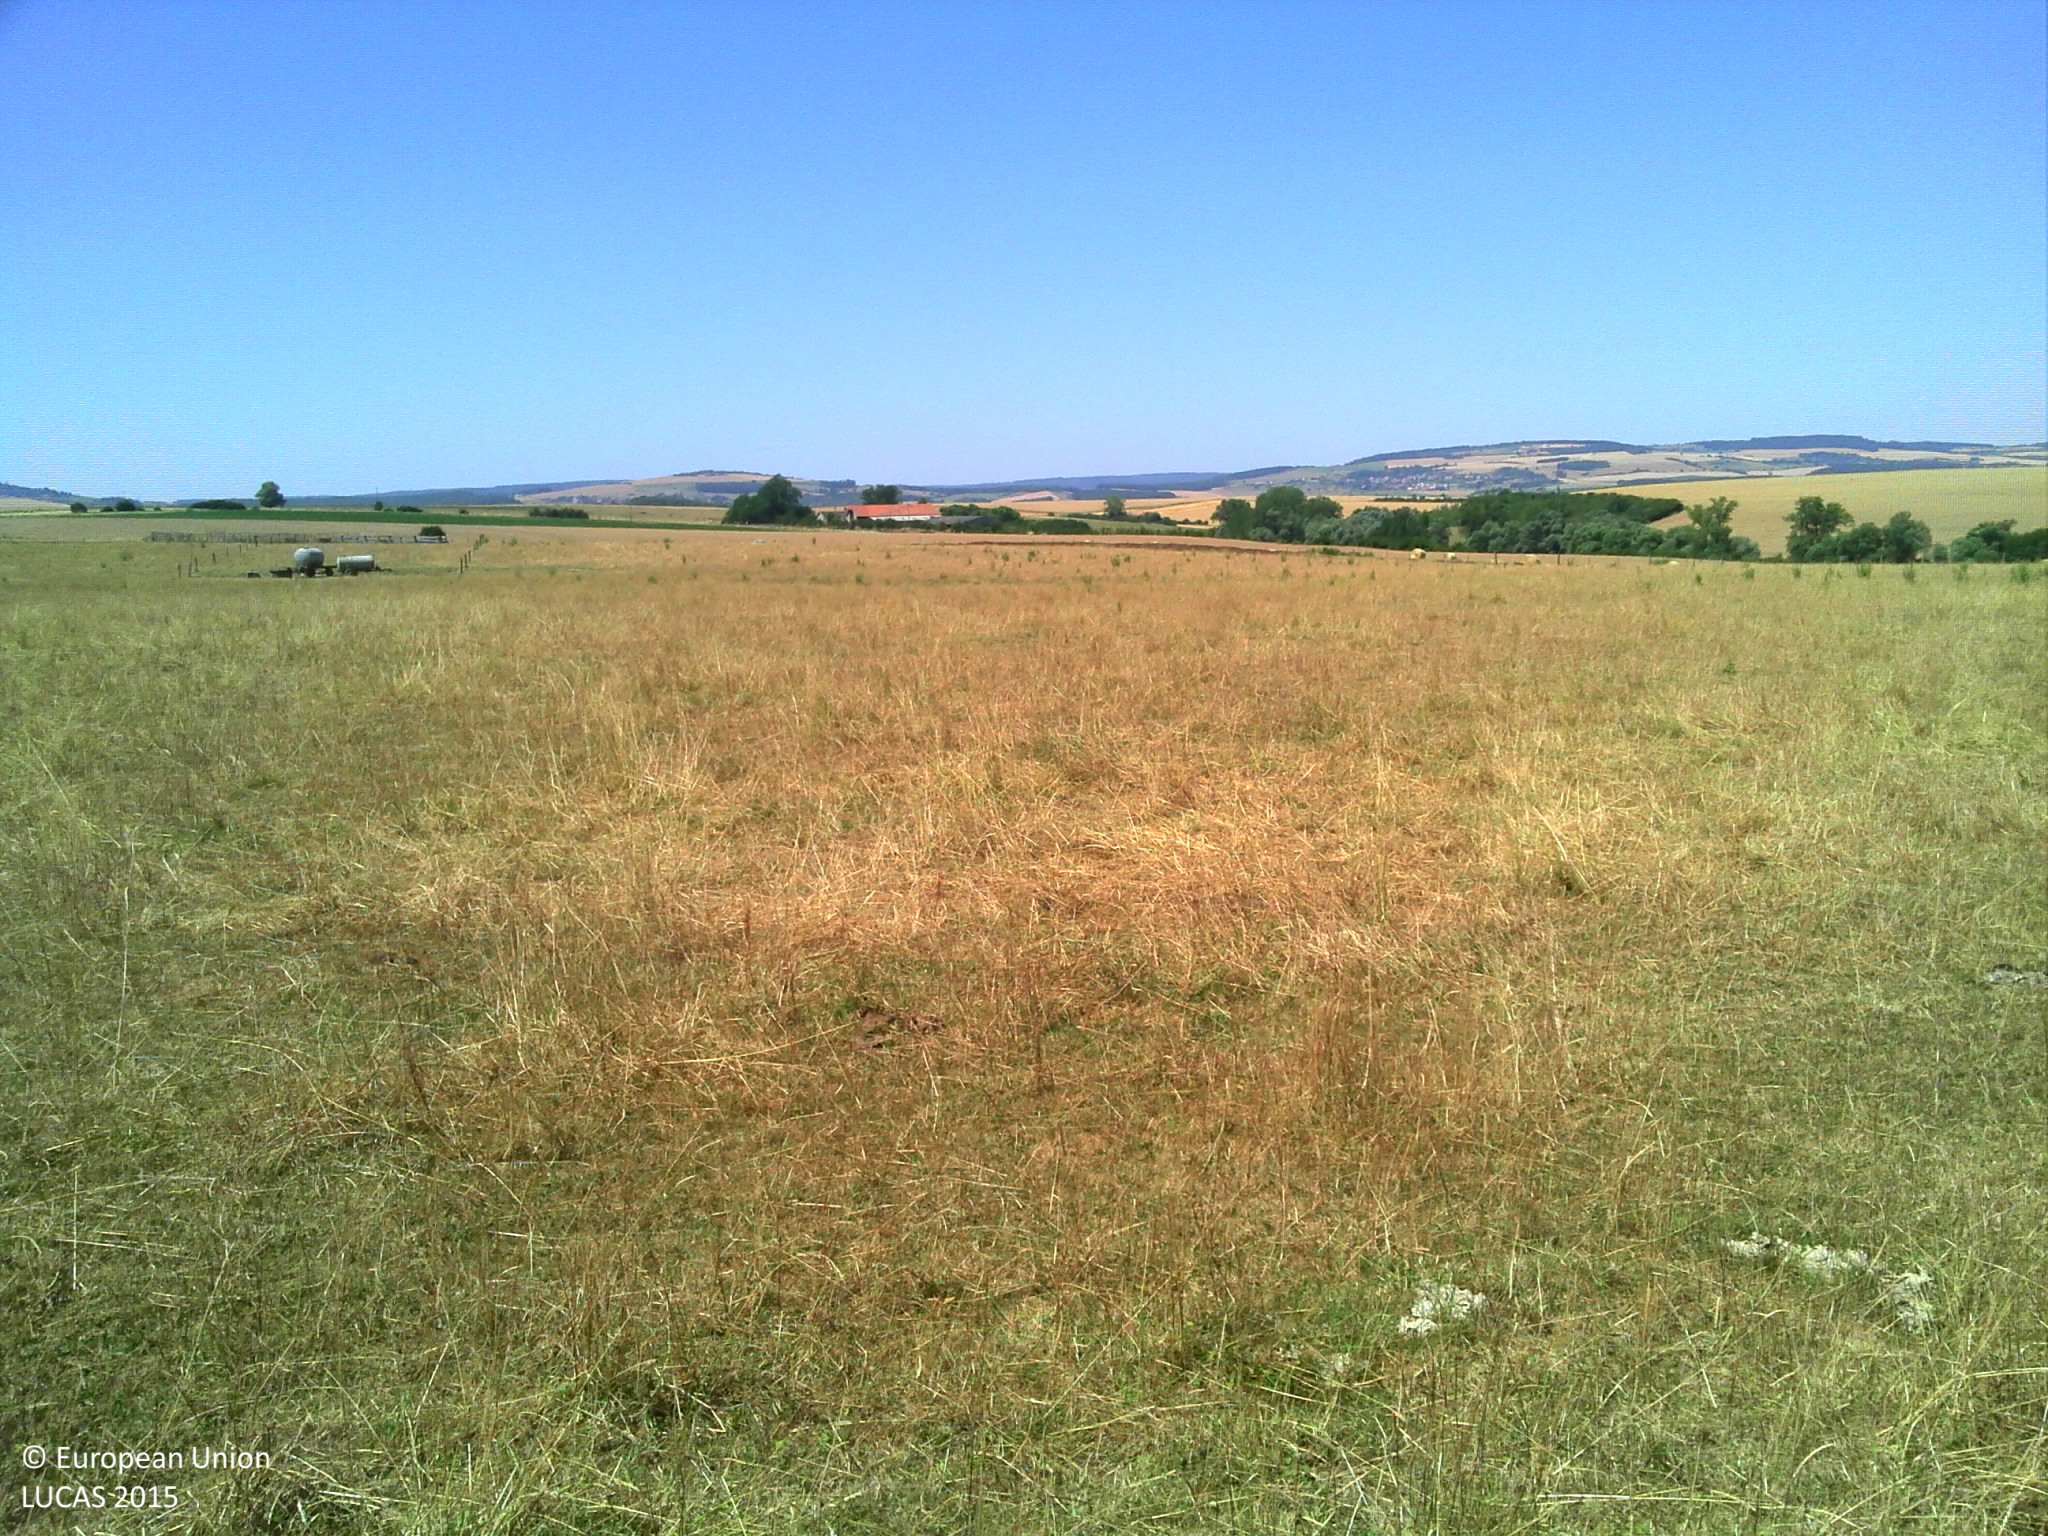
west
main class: Grassland
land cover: Grassland without tree/shrub cover
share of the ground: > 75 %
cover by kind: herbaceous plants 100 %
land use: Agriculture (excluding fallow land and kitchen gardens)
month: July
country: FR
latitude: 48.9323
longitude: 6.1914
